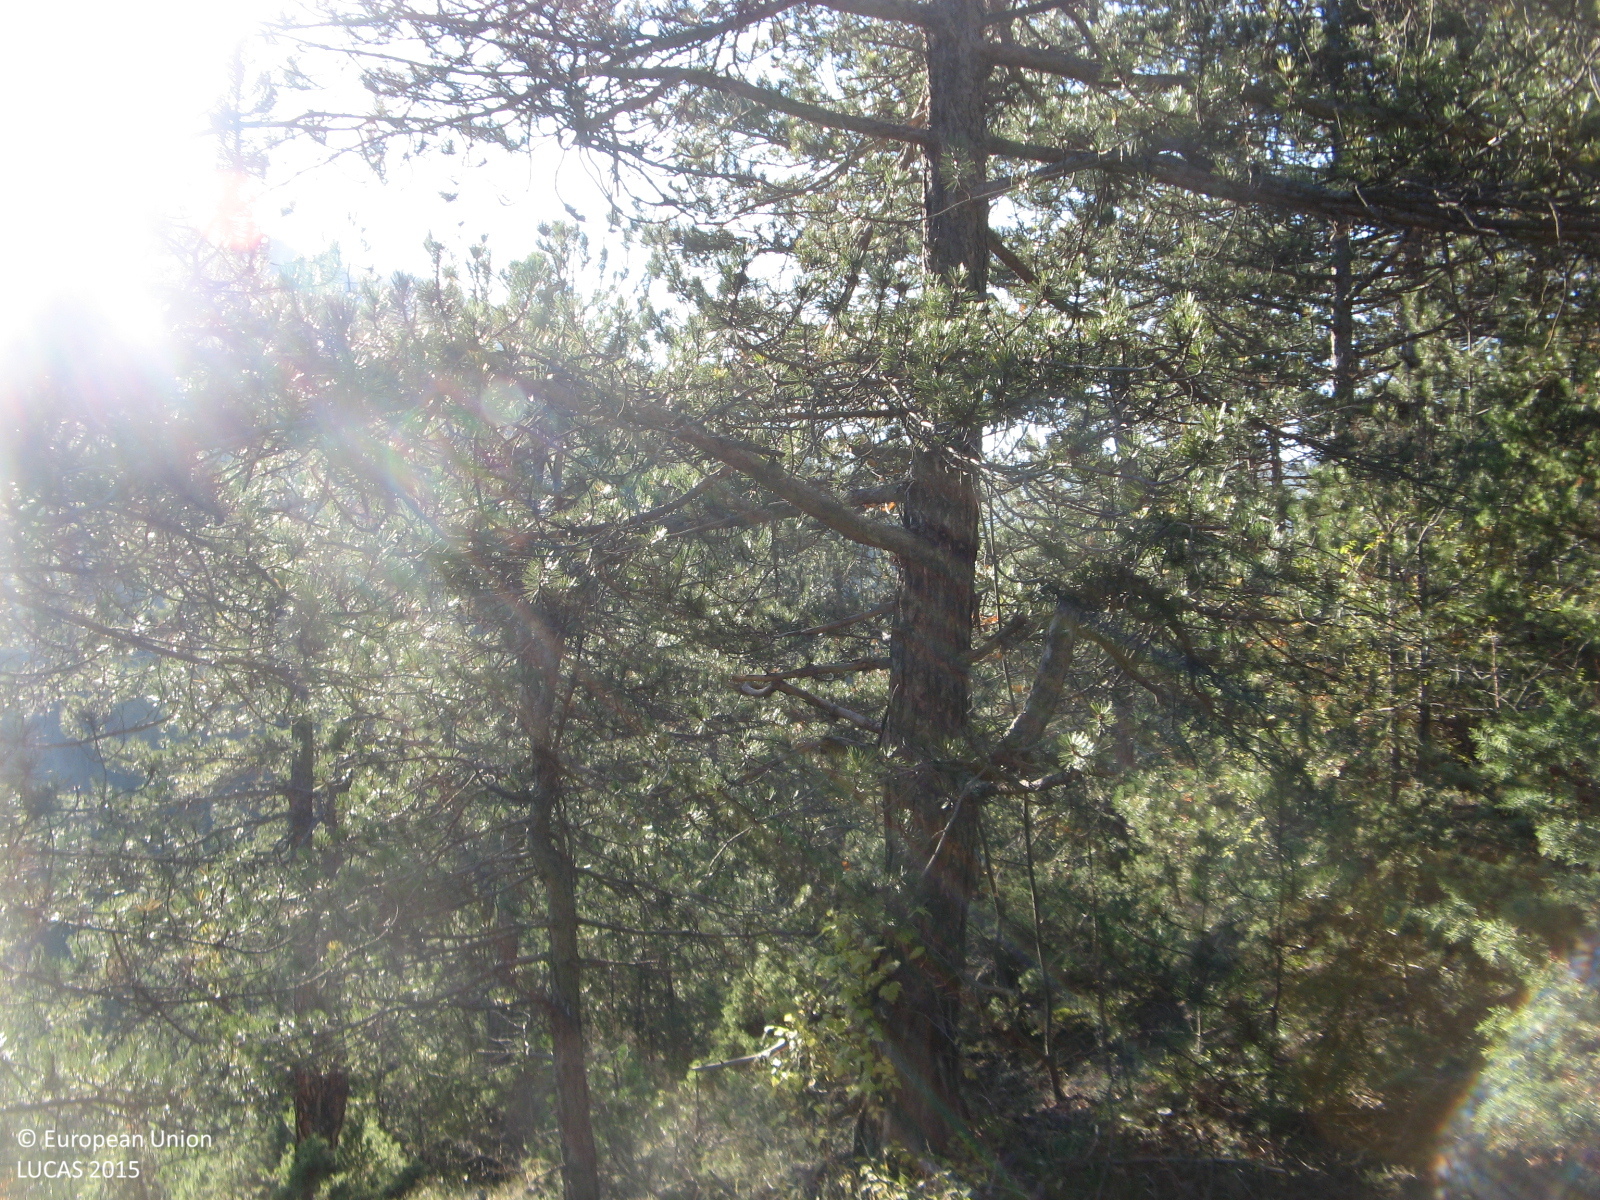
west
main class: Woodland
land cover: Pine dominated coniferous woodland
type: hemiboreal forest and nemoral coniferous forest and mixed broadleaved-coniferous forest
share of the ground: 50 - 75 %
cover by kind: coniferous forest trees 70 %, unconsolidated bare surface 15 %, herbaceous plants 10 %, shrubs 5 %
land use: Forestry
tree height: > 5 m
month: October
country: BG
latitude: 41.8524
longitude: 24.6815
